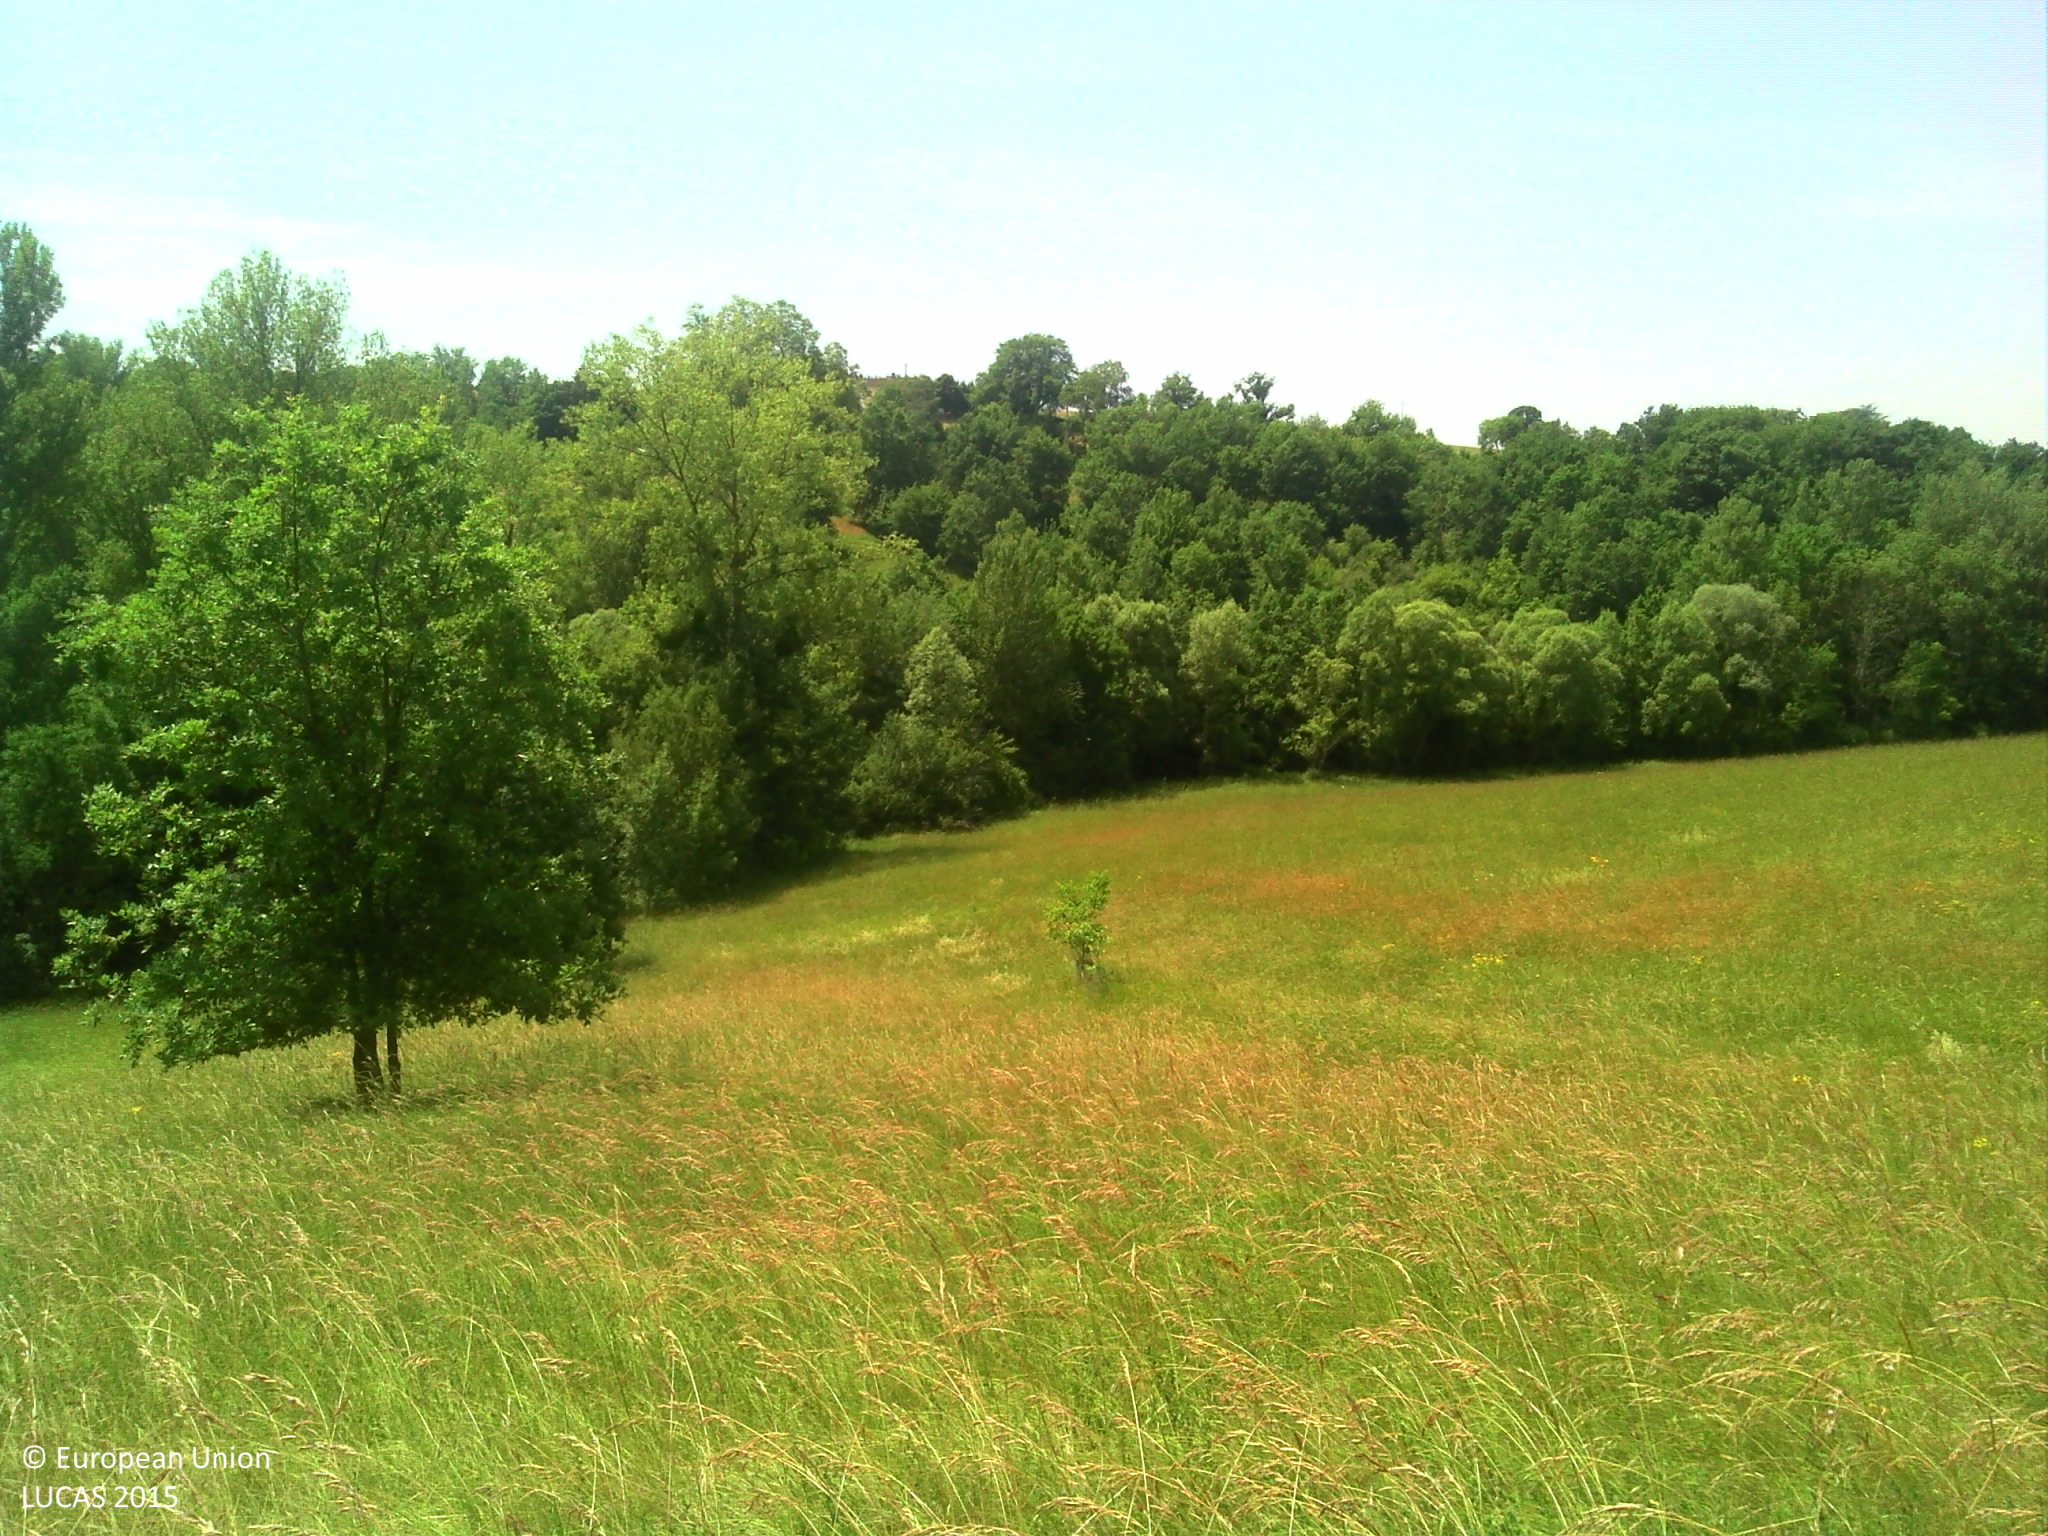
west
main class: Grassland
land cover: Grassland without tree/shrub cover
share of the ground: > 75 %
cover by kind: herbaceous plants 100 %
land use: Agriculture (excluding fallow land and kitchen gardens)
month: June
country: FR
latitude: 43.9543
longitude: 1.5900
